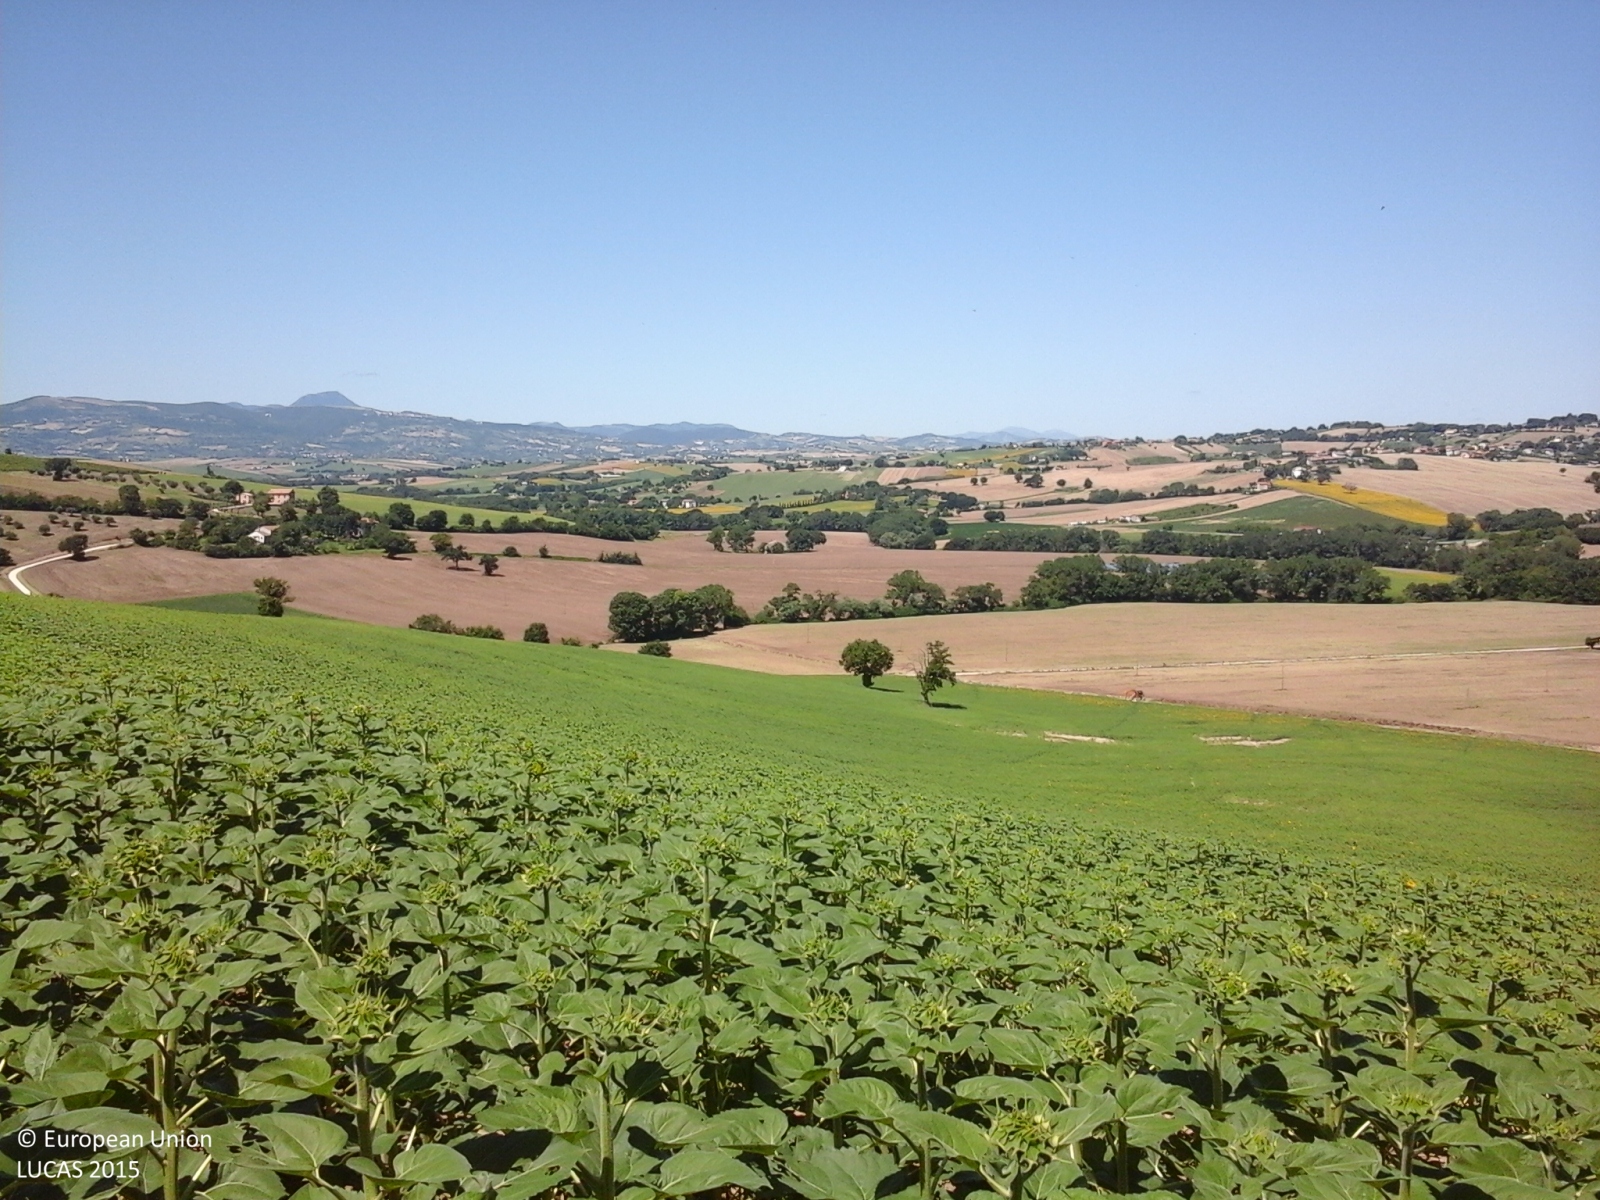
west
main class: Cropland
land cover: Sunflower
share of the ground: > 75 %
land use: Agriculture (excluding fallow land and kitchen gardens)
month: June
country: IT
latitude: 43.4105
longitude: 13.3875
